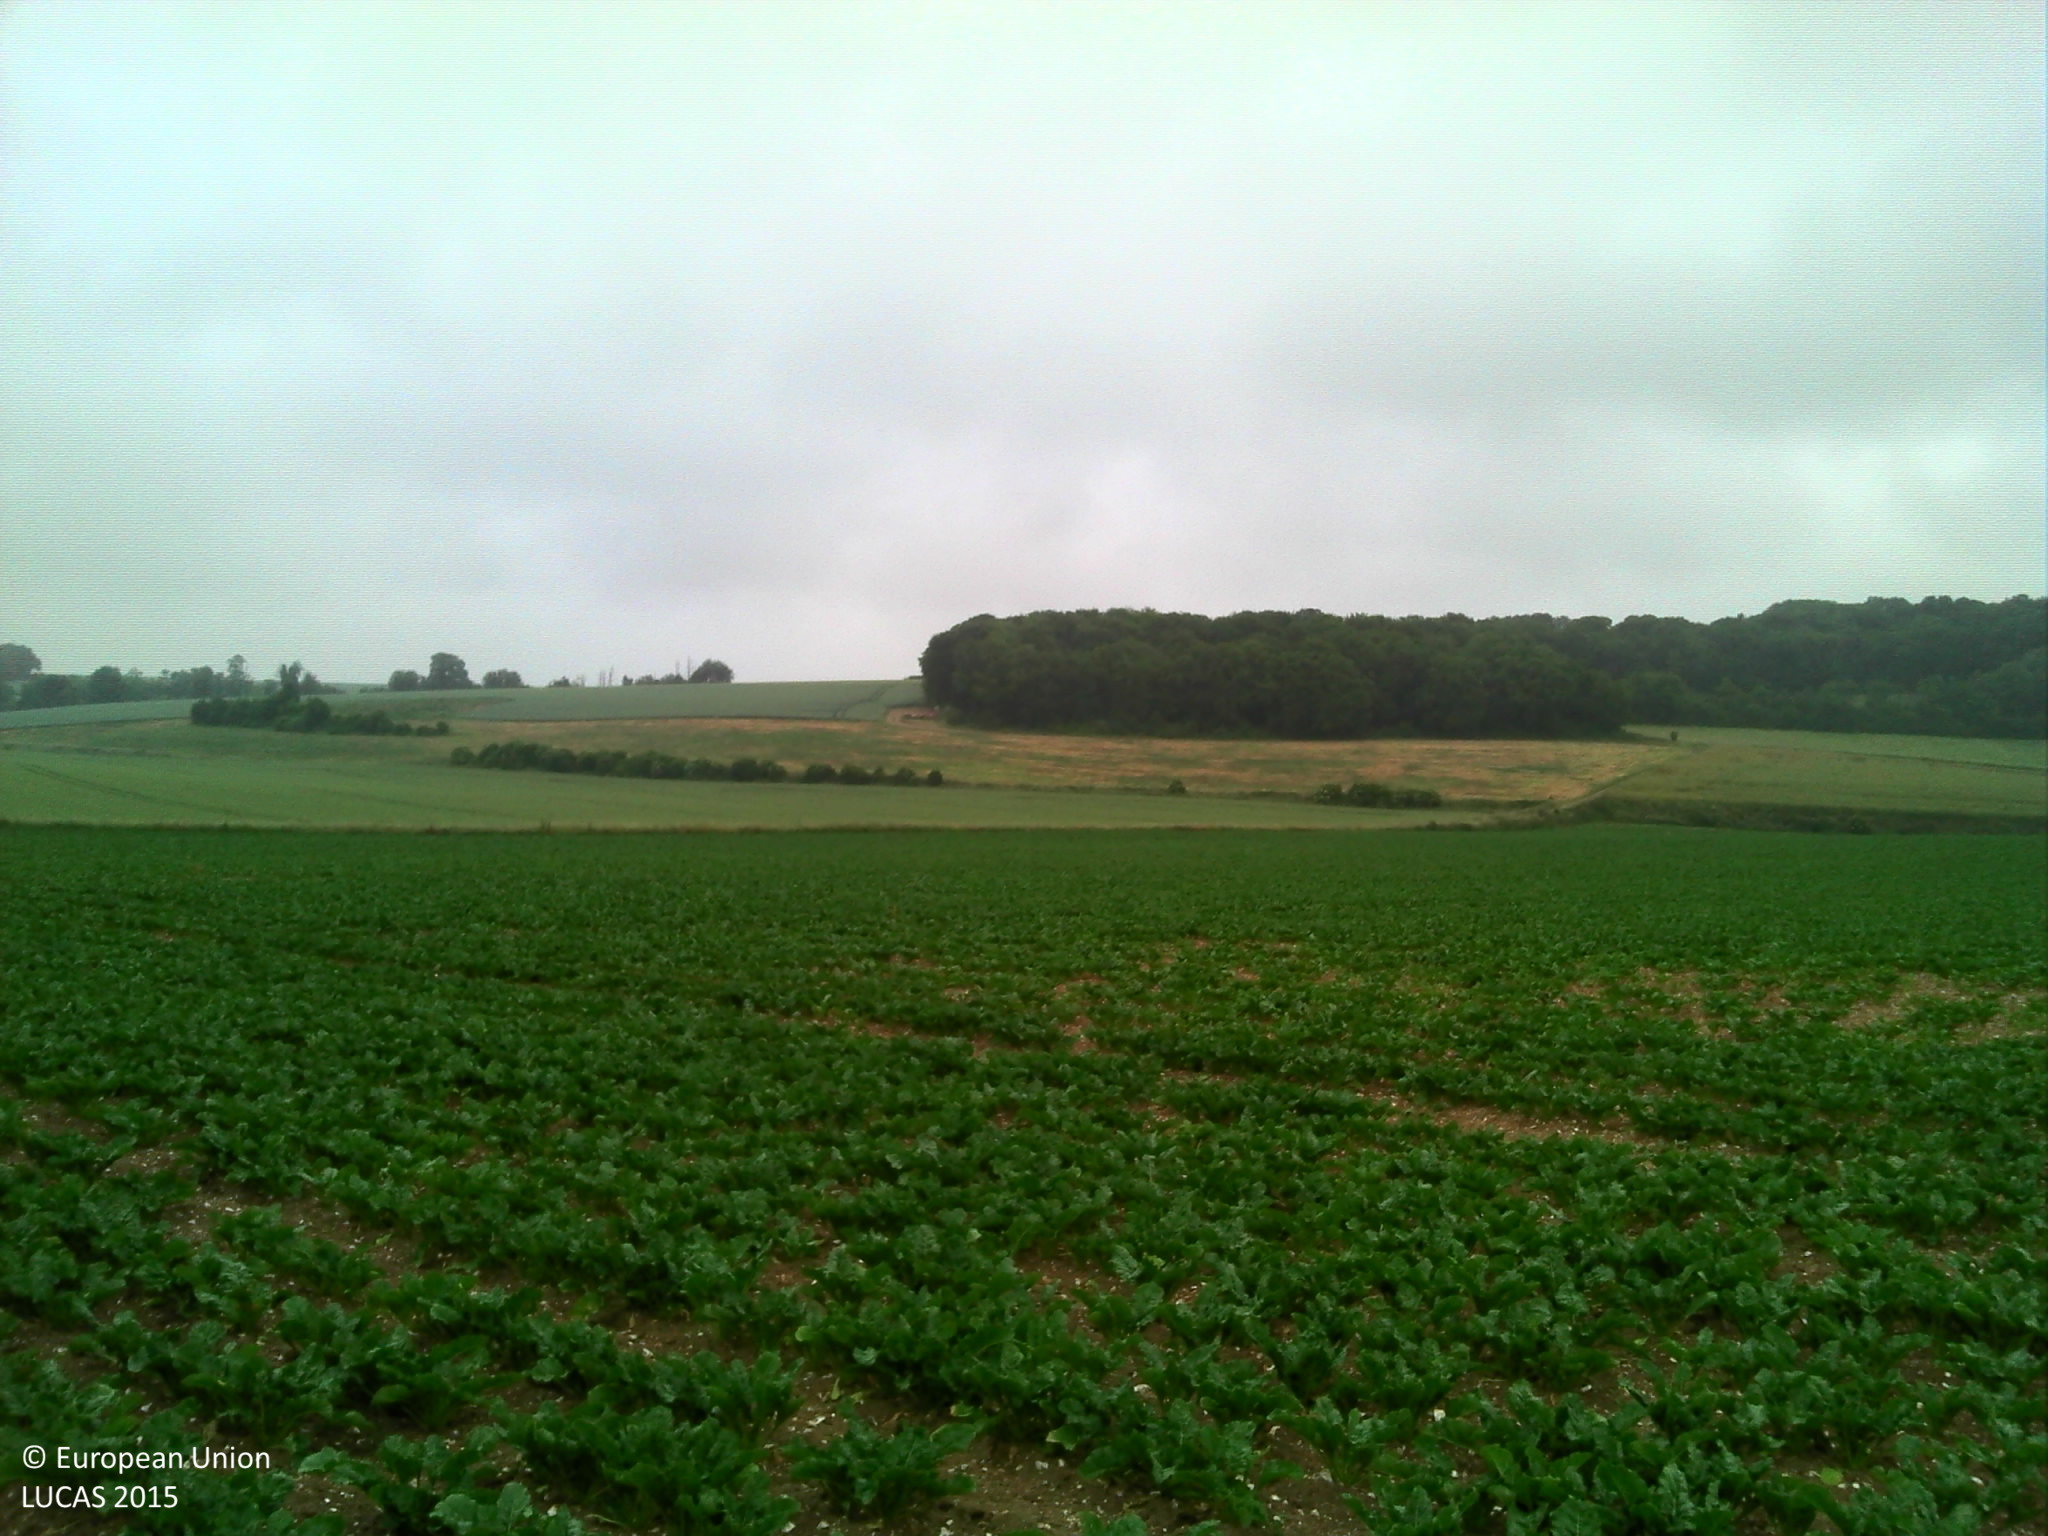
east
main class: Cropland
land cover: Sugar beet
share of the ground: 50 - 75 %
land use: Agriculture (excluding fallow land and kitchen gardens)
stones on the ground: < 10 %
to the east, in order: Sugar beet; Grass margins; Tracks; Grass margins; Ditches and canals; Common wheat
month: June
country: FR
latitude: 49.4635
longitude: 2.4404
